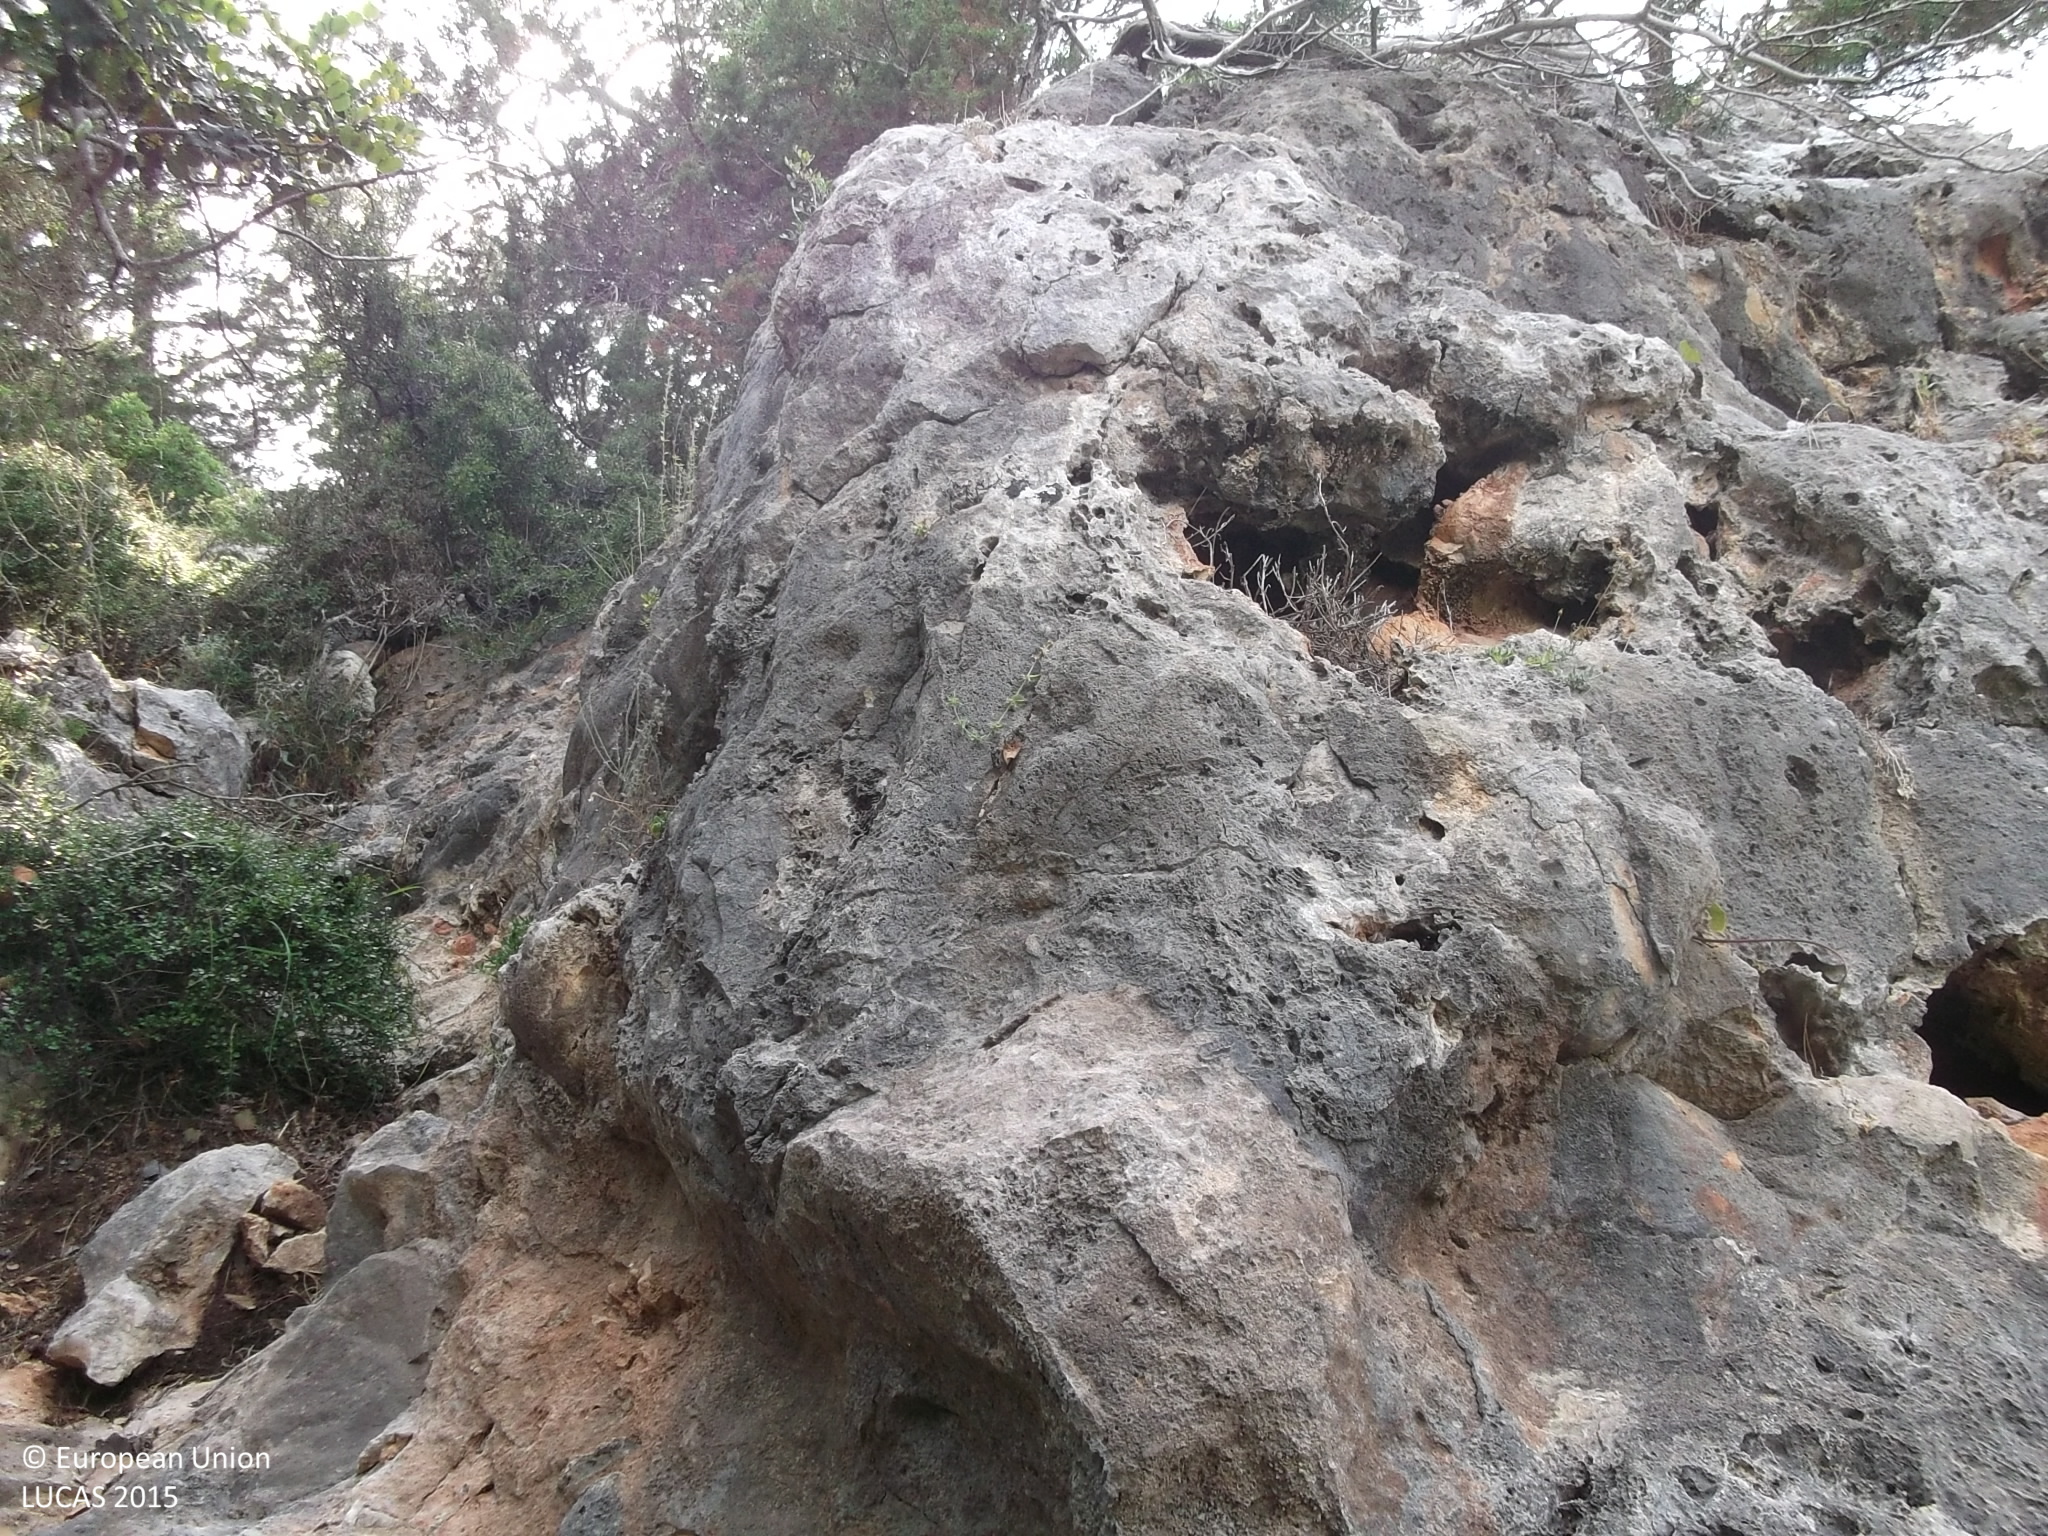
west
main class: Woodland
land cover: Pine dominated coniferous woodland
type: coniferous forest of the mediterranean region
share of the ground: 50 - 75 %
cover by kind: coniferous forest trees 75 %, unconsolidated bare surface 25 %
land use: Semi-natural and natural areas not in use
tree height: < 5 m
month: May
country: CY
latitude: 35.0559
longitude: 32.3311
